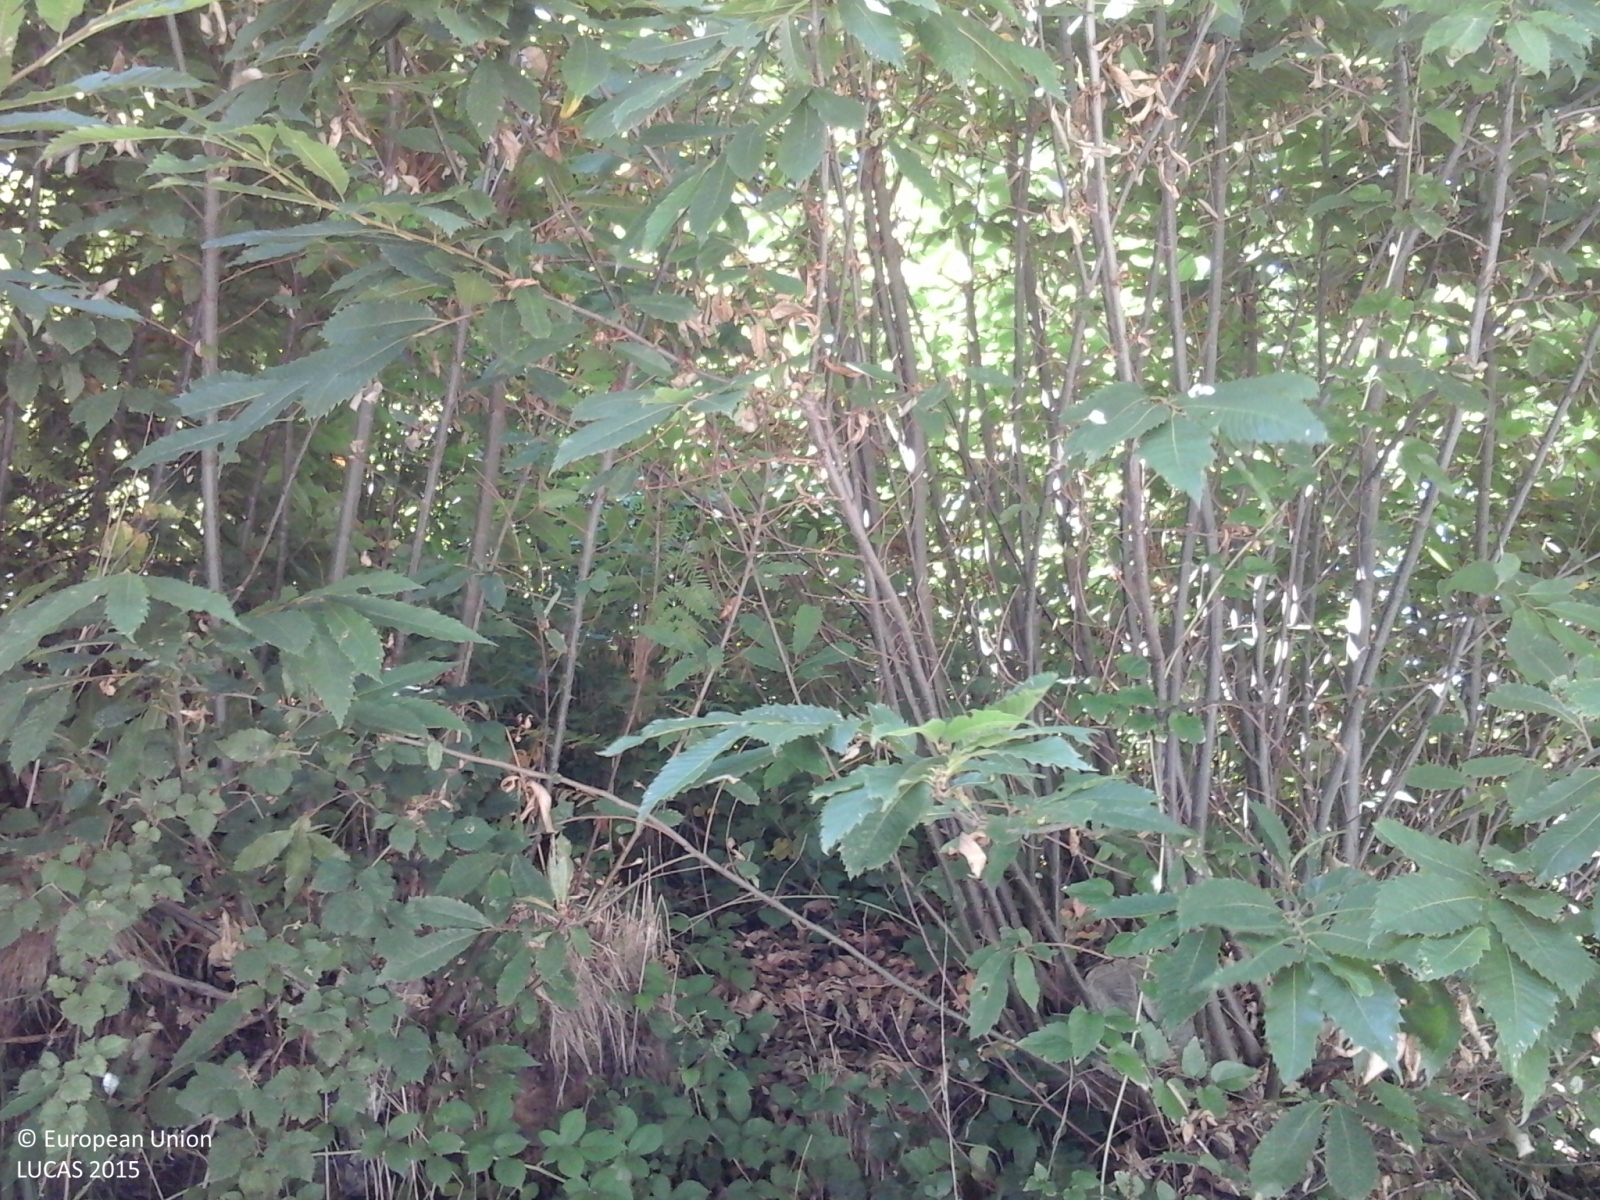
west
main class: Woodland
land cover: Broadleaved woodland
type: thermophilous deciduous forest
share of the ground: > 75 %
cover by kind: broadleaved forest trees 100 %
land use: Forestry
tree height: > 5 m
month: August
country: IT
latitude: 40.2451
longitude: 15.0675
